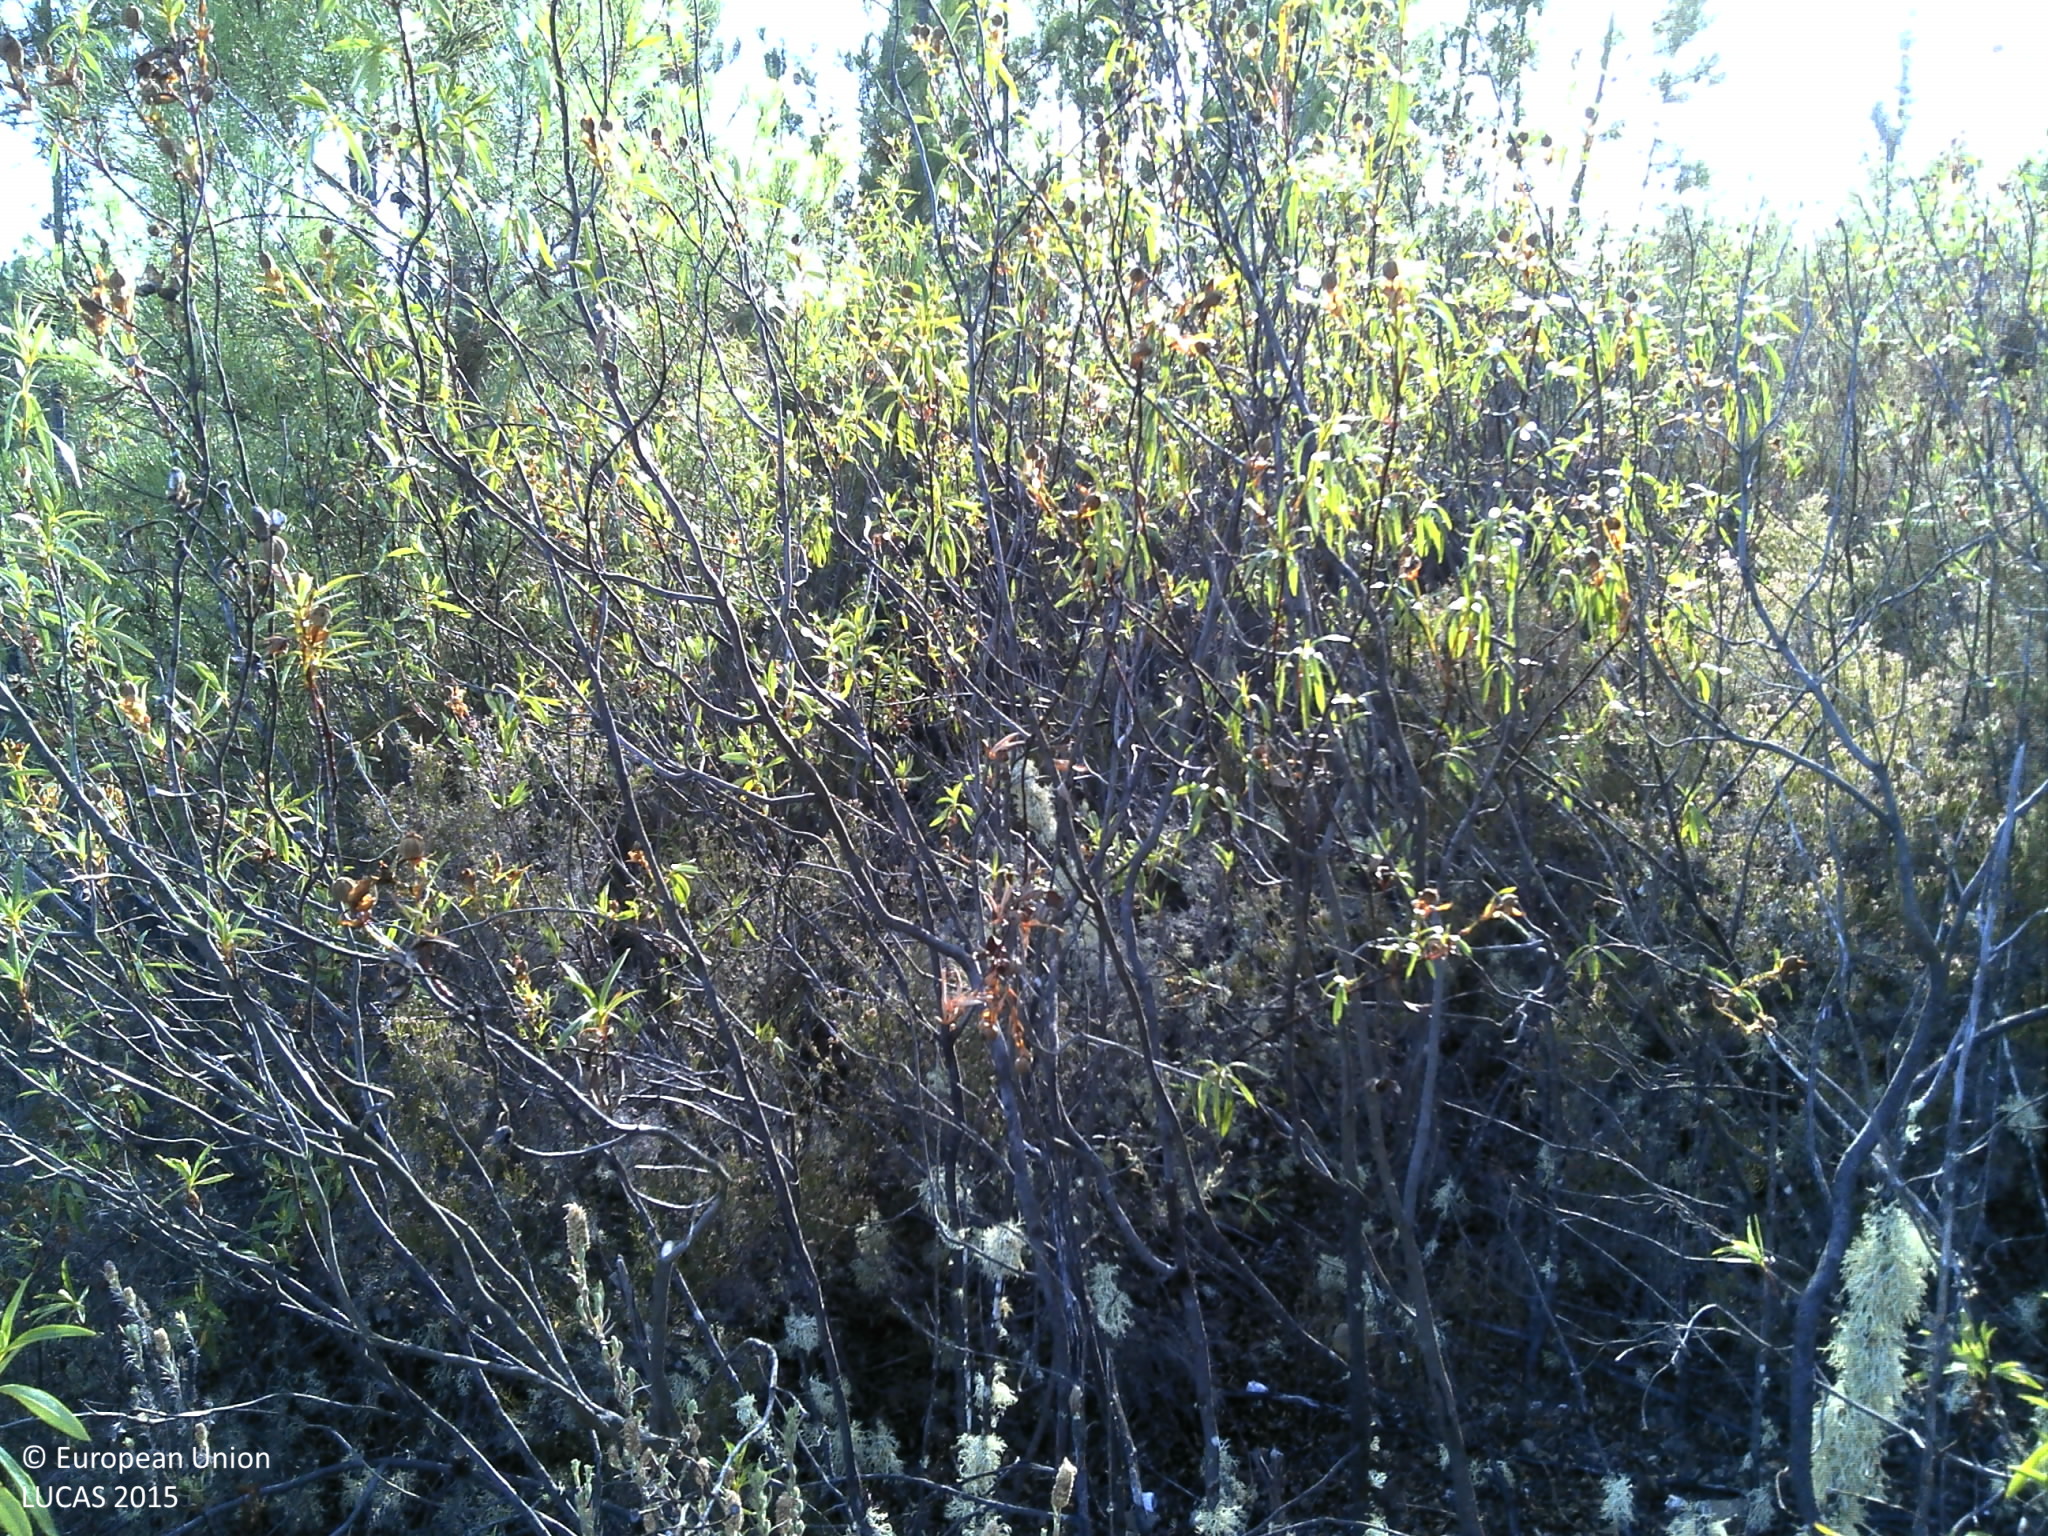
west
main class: Woodland
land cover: Pine dominated coniferous woodland
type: coniferous forest of the mediterranean region
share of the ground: < 10 %
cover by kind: shrubs 90 %, coniferous forest trees 10 %
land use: Forestry
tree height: < 5 m
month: July
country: PT
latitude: 39.7322
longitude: -7.8052
